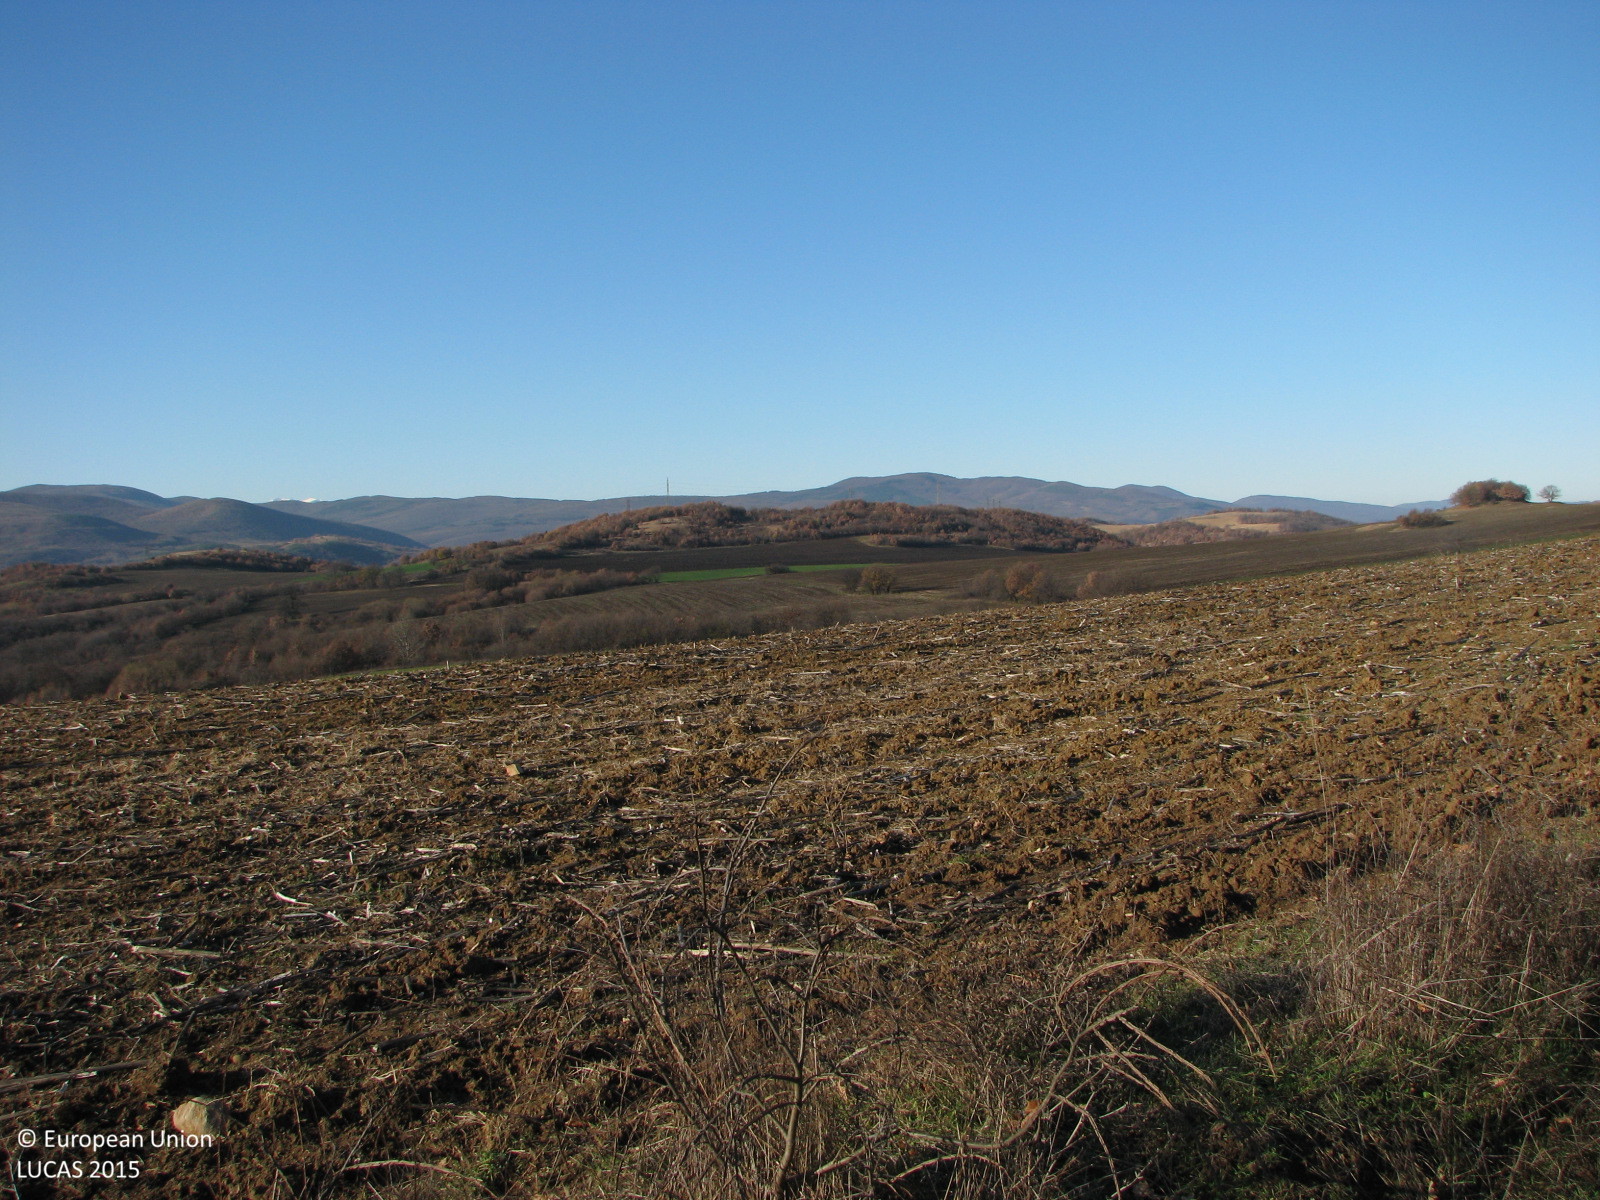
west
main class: Shrubland
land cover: Shrubland with sparse tree cover
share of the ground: 50 - 75 %
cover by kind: shrubs 60 %, herbaceous plants 35 %, broadleaved forest trees 5 %
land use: Semi-natural and natural areas not in use
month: December
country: BG
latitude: 42.4449
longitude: 24.2588
